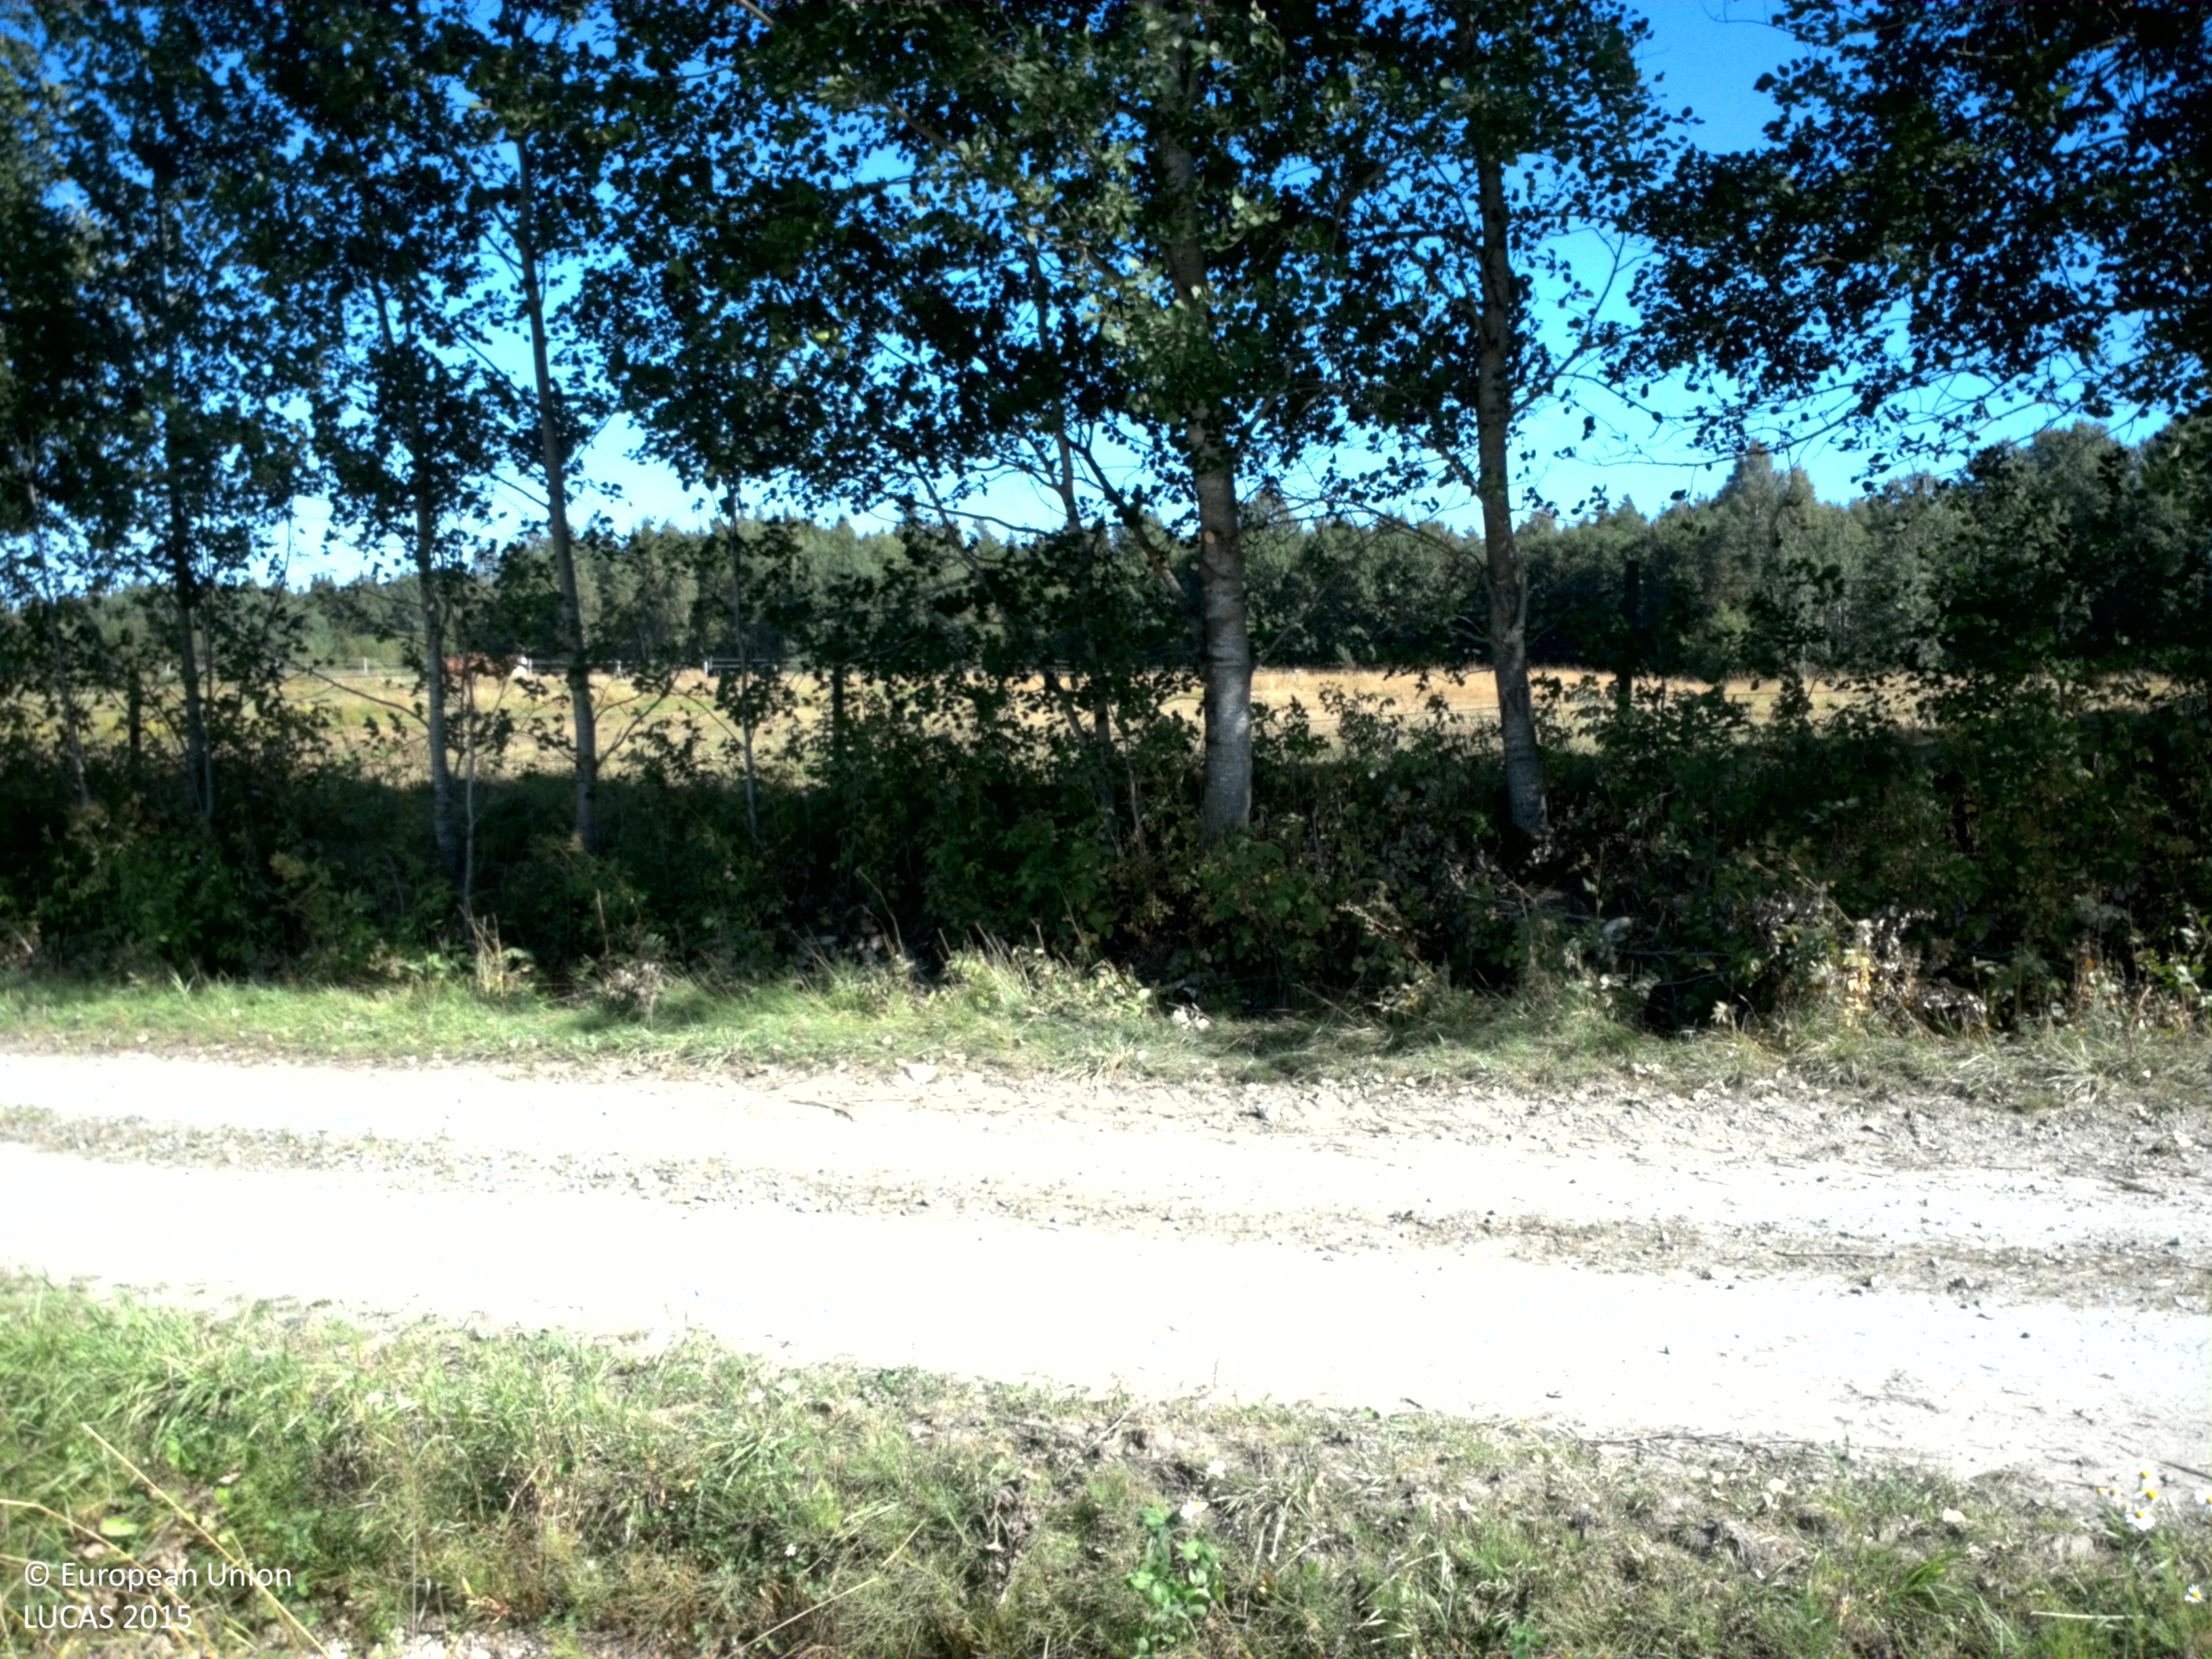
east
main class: Cropland
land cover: Other leguminous and mixtures for fodder
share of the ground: > 75 %
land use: Agriculture (excluding fallow land and kitchen gardens)
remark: Harvested field
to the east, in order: Other leguminous and mixtures for fodder; Ditches and canals; Grass margins; Paved roads, cycling and walking lanes; Grass margins; Ditches and canals; Groves; Fences; Grassland without tree/shrub cover; Fences; Grass margins; Ditches and canals; Paved roads, cycling and walking lanes; Ditches and canals; Grass margins; Fences; Grassland without tree/shrub cover; Fences; Broadleaved woodland; Ditches and canals; Spruce dominated coniferous woodland; Ditches and canals; Spruce dominated coniferous woodland; Tracks; Spruce dominated coniferous woodland
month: August
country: SE
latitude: 59.4013
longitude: 13.3915
